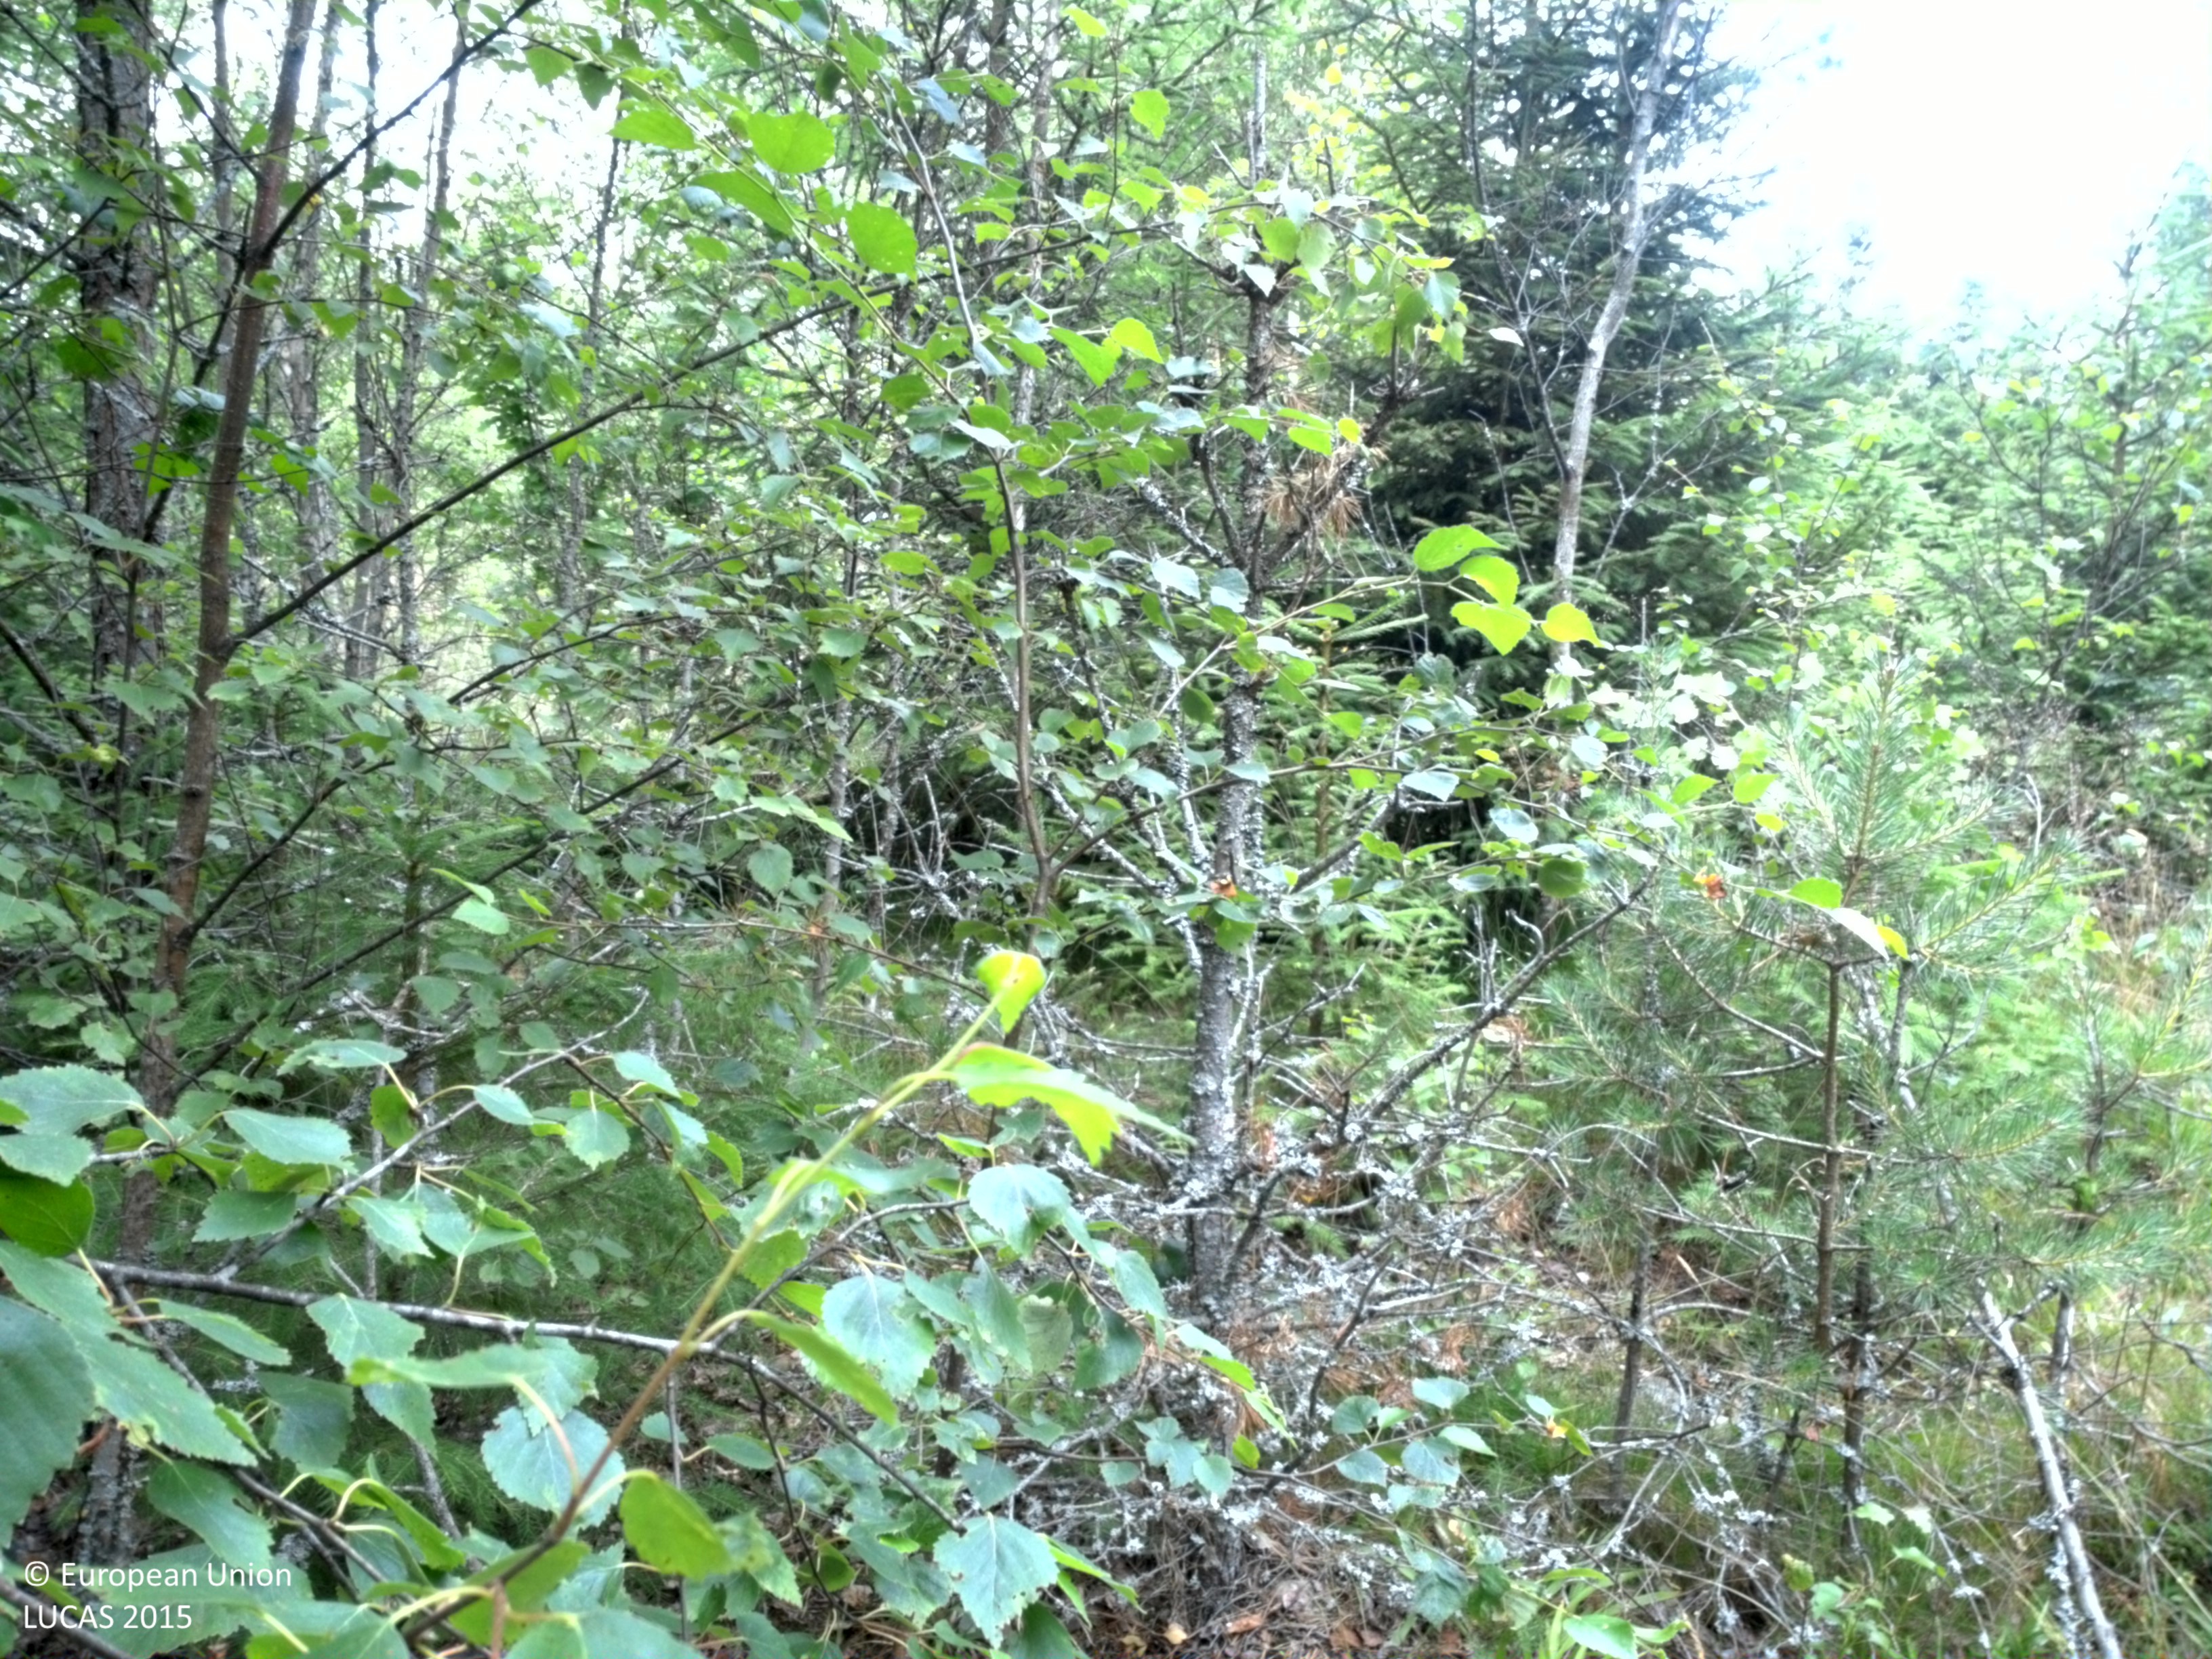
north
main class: Woodland
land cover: Broadleaved woodland
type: hemiboreal forest and nemoral coniferous forest and mixed broadleaved-coniferous forest
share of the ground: > 75 %
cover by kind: broadleaved forest trees 80 %, herbaceous plants 20 %
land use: Forestry
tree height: < 5 m
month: July
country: SE
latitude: 57.5228
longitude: 14.7546
